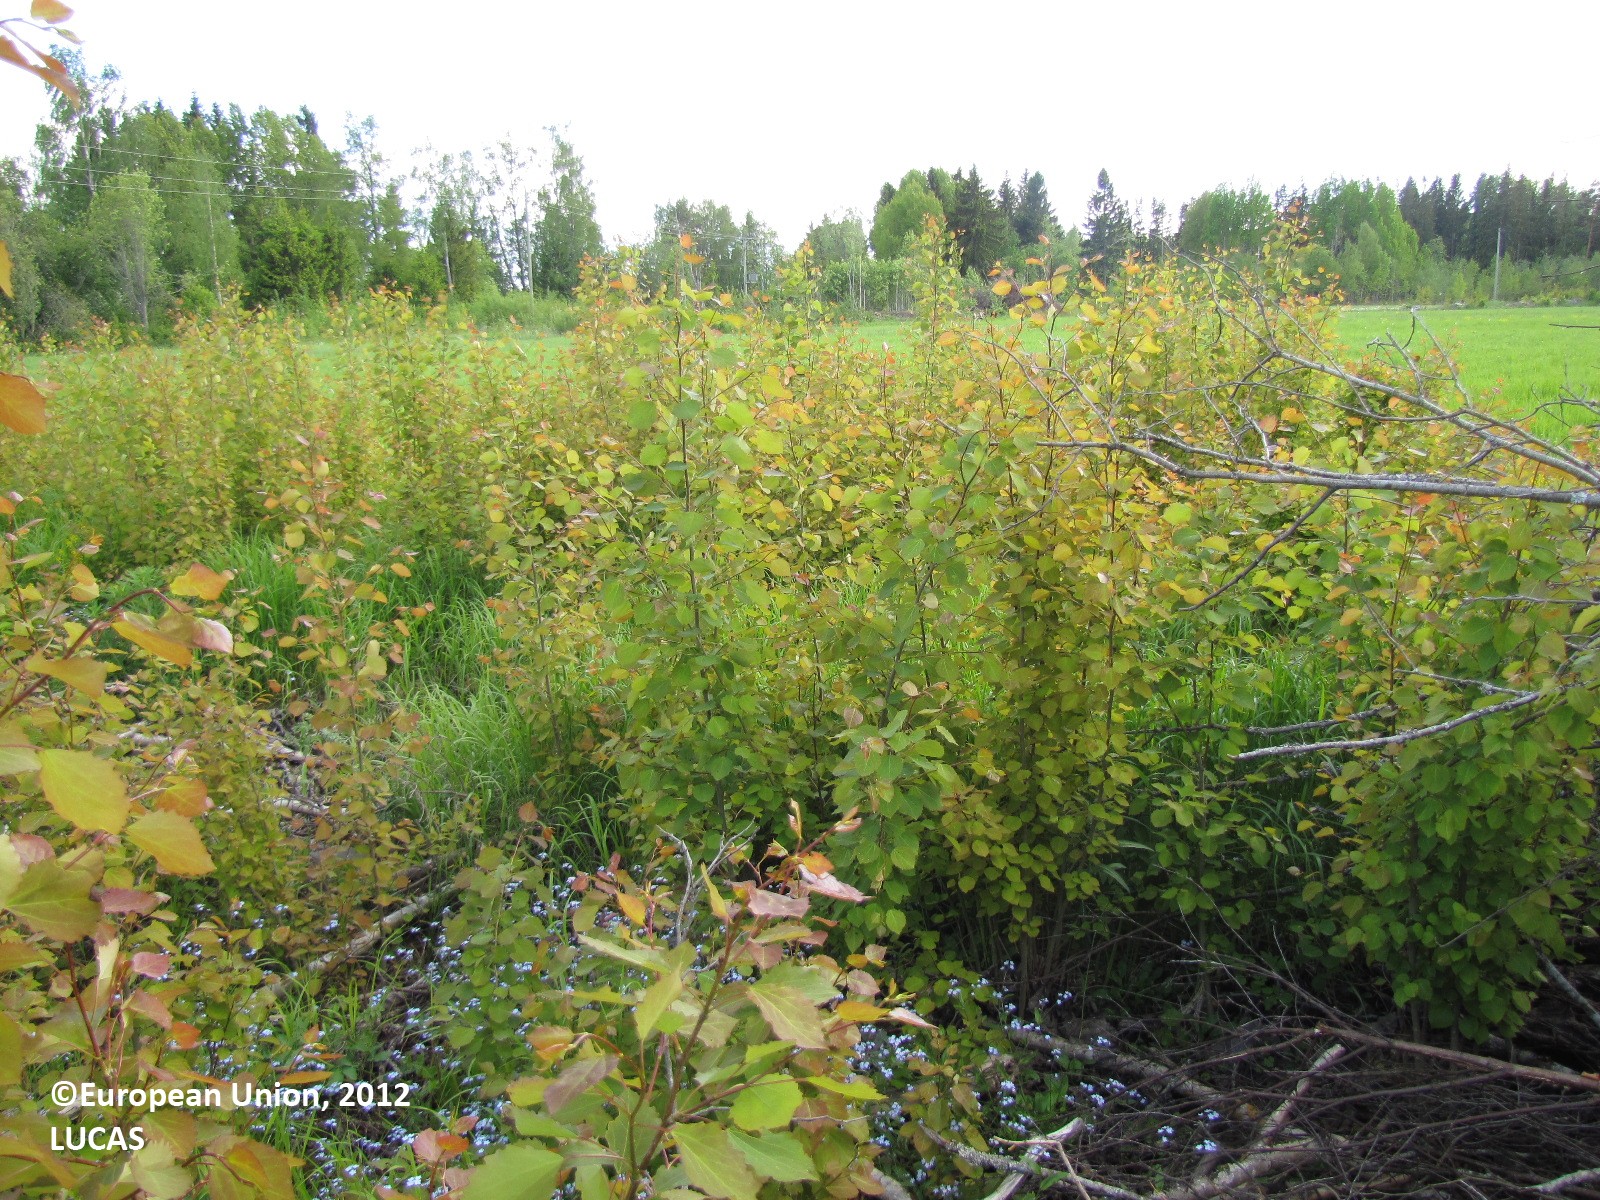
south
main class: Woodland
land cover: Broadleaved woodland
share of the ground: 25 - 50 %
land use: Semi-natural and natural areas not in use
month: June
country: FI
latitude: 61.4213
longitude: 23.0209
